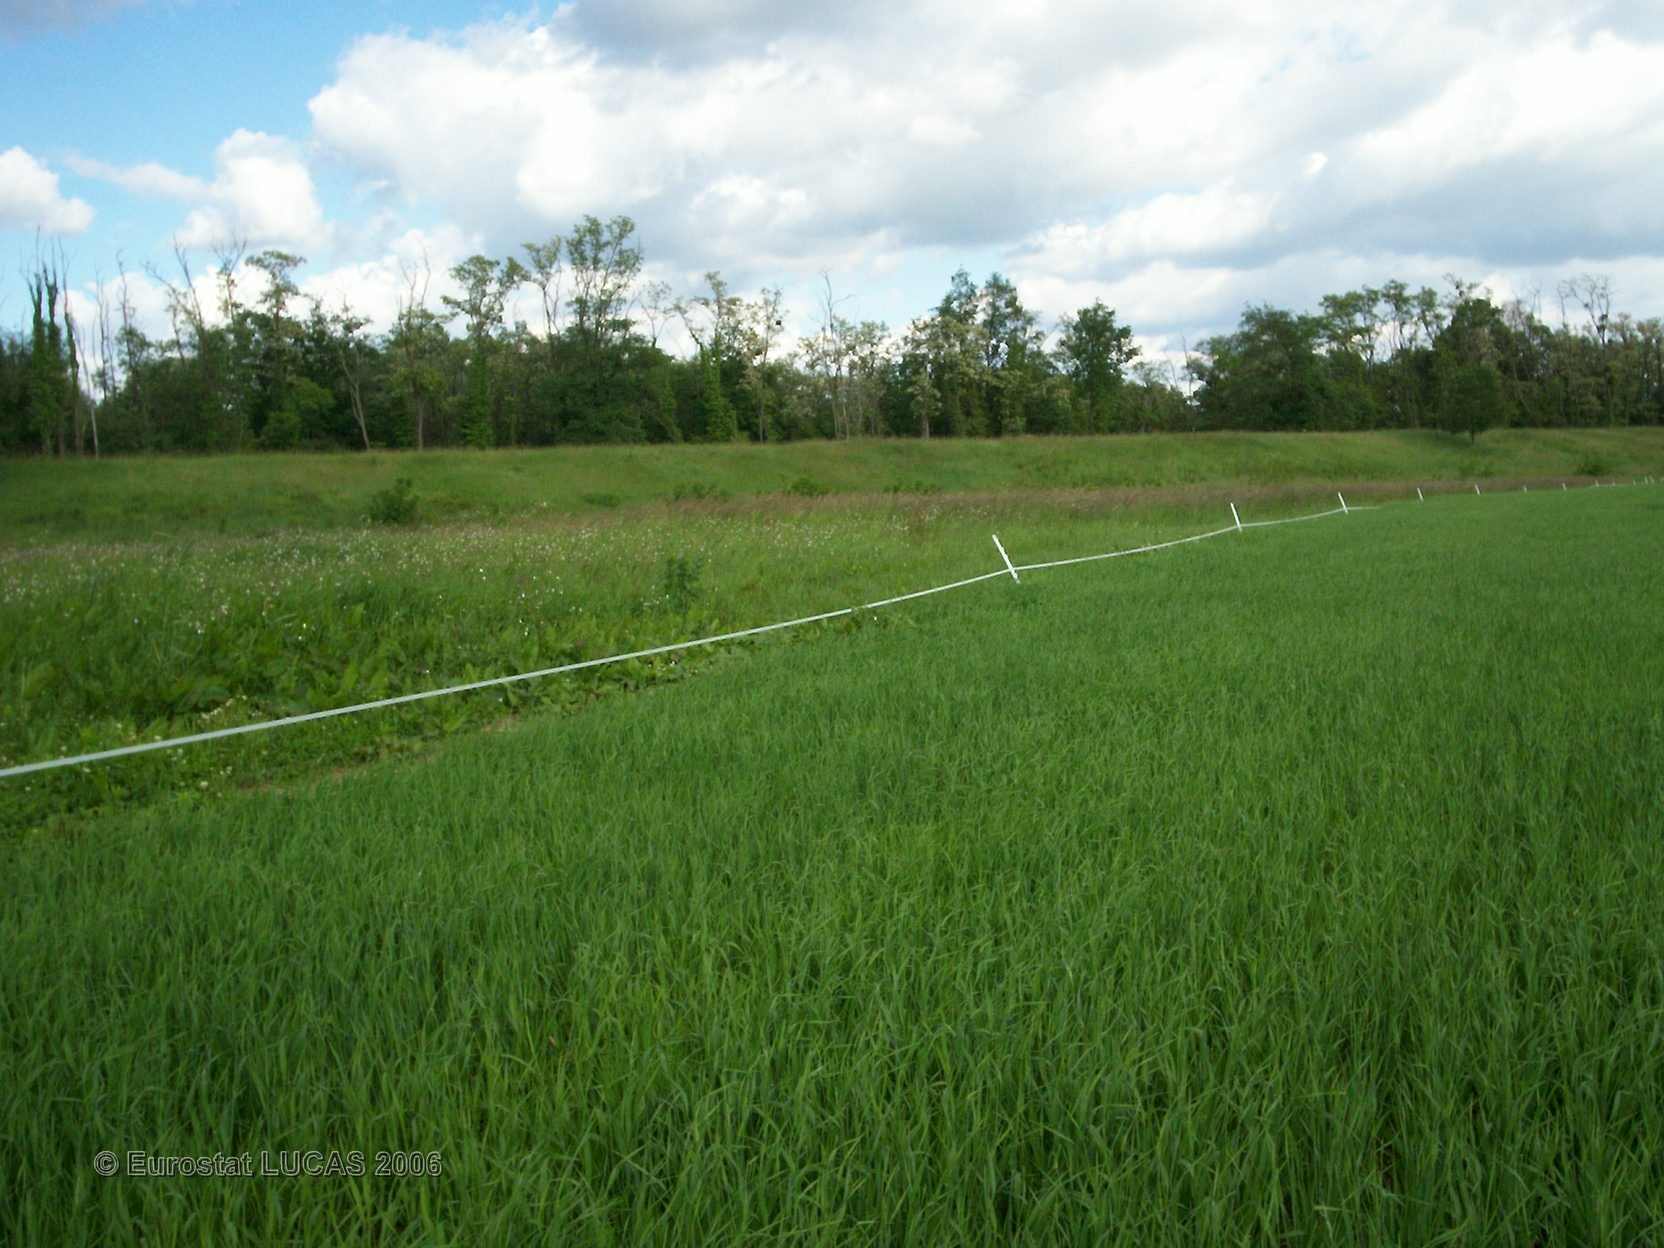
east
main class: Cropland
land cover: Barley
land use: Agriculture (excluding fallow land and kitchen gardens)
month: June
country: FR
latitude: 47.1172
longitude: 3.0232
